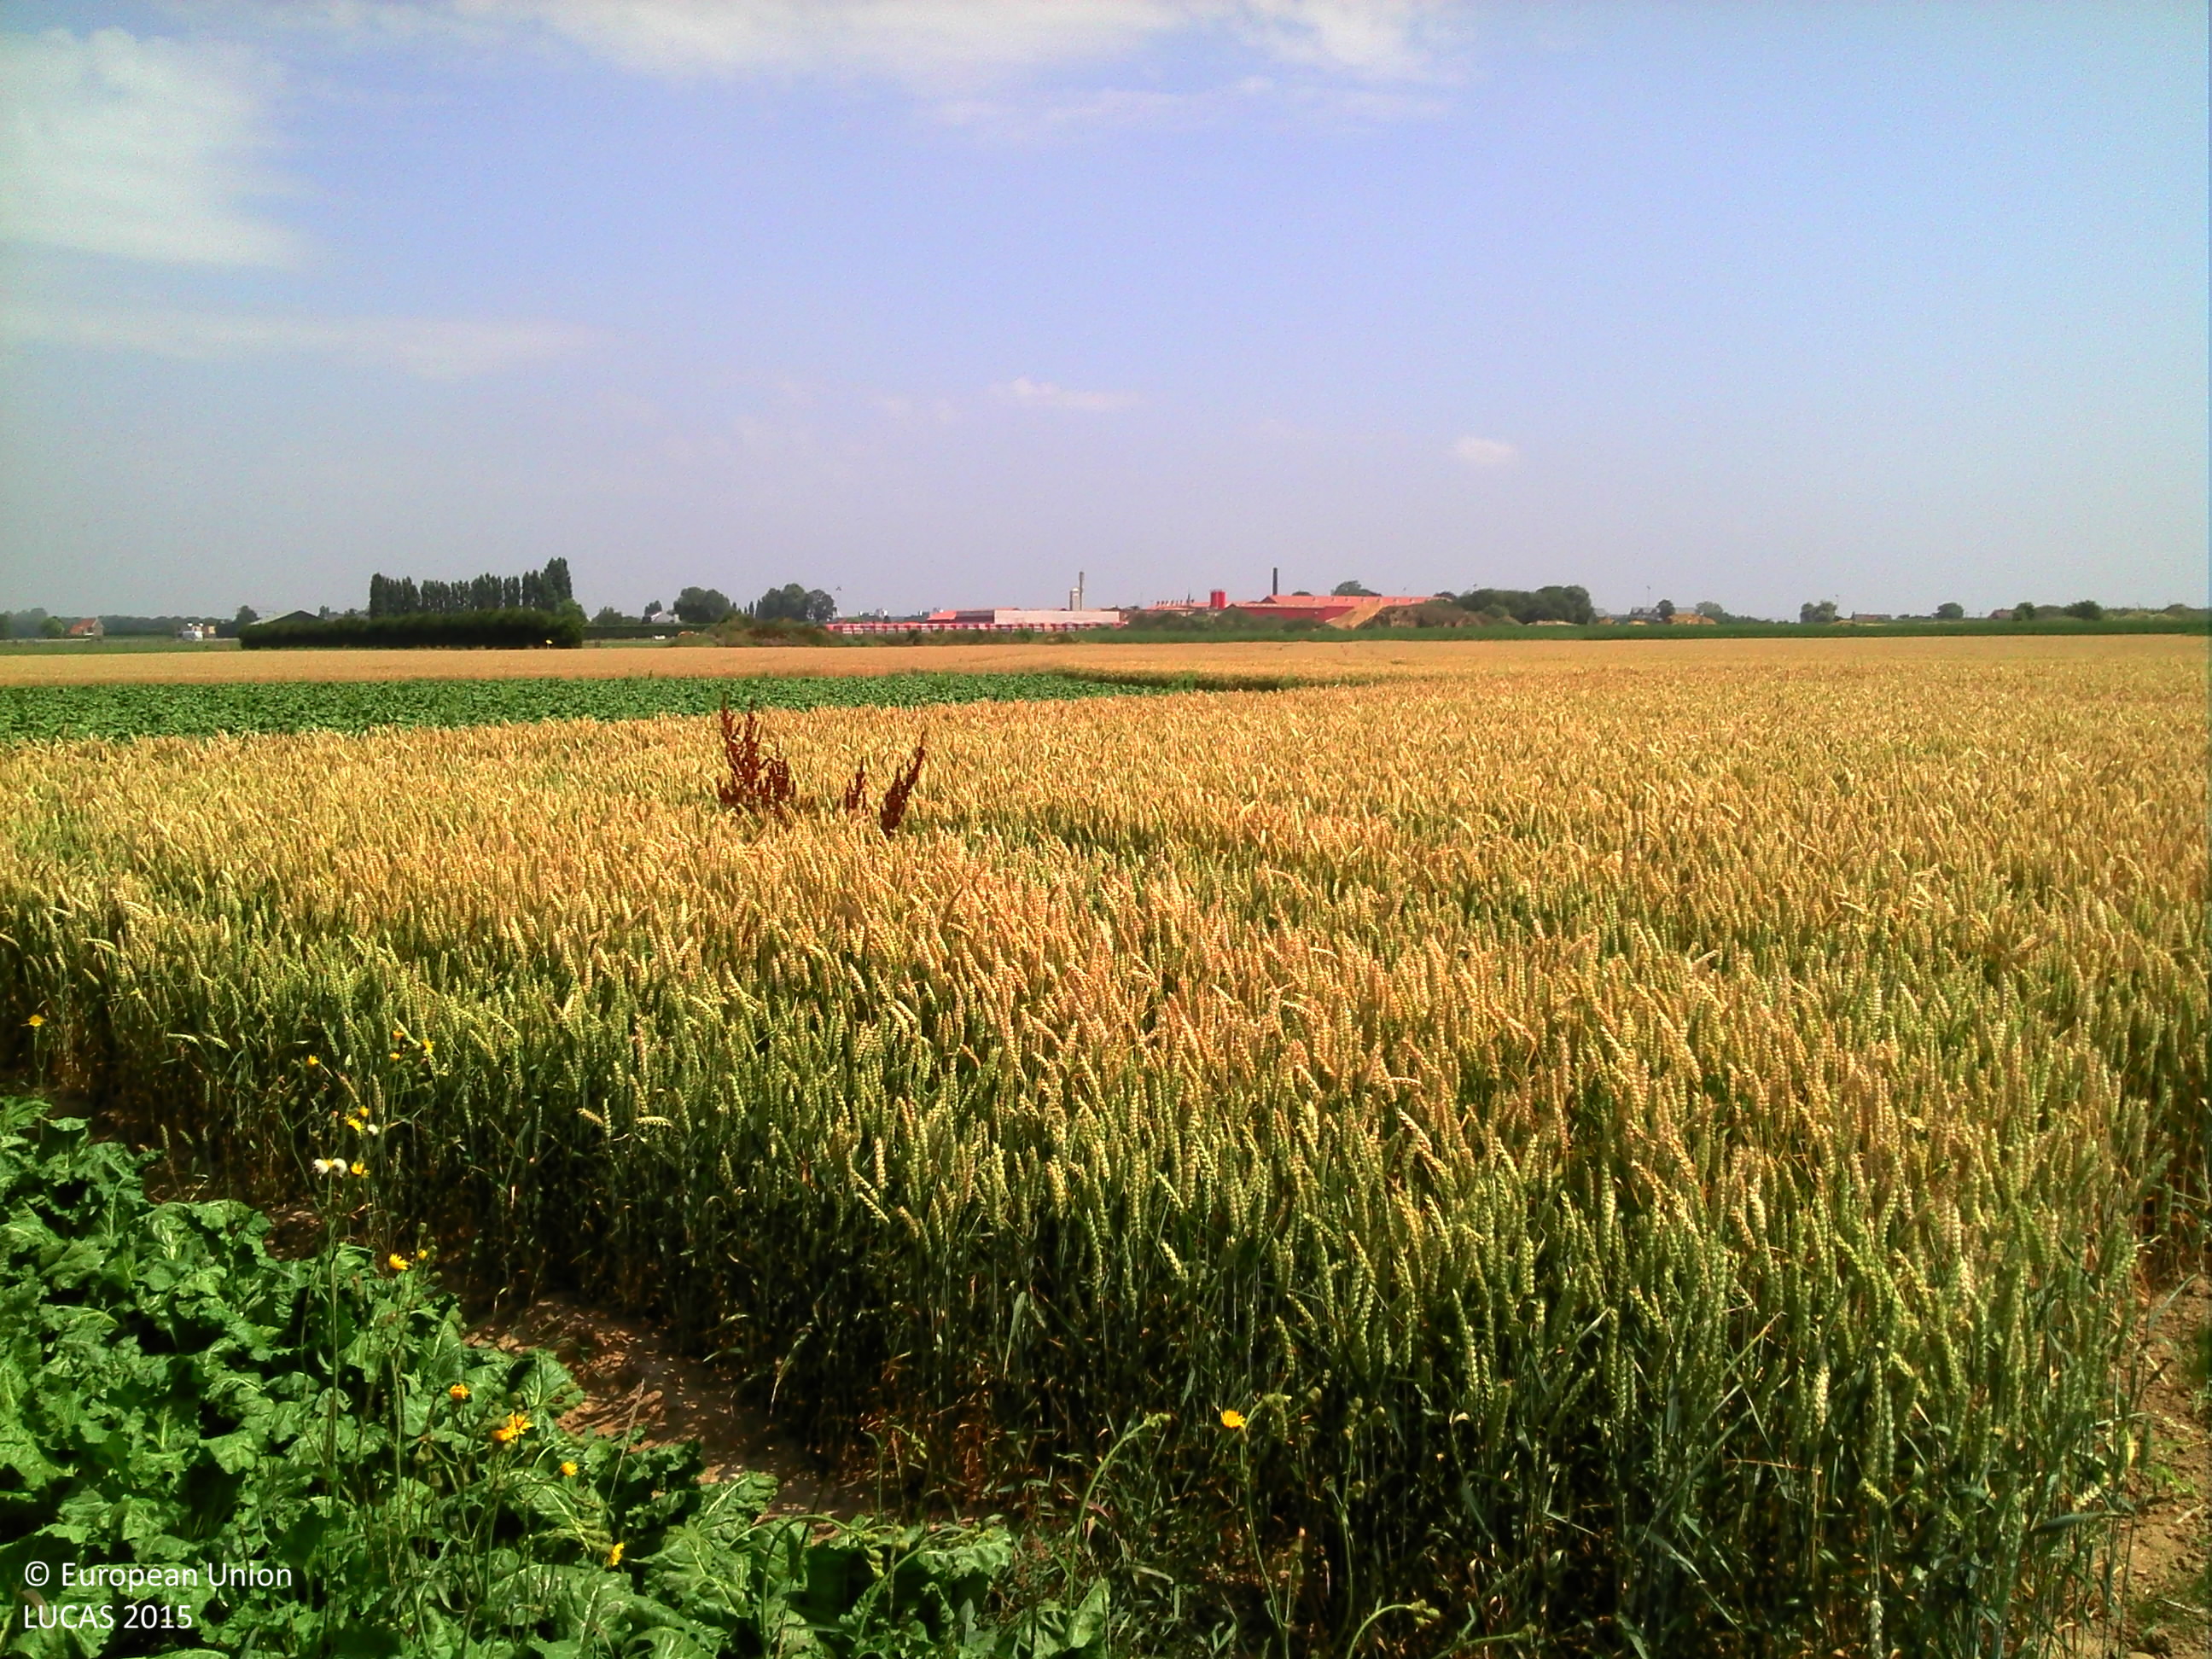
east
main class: Cropland
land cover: Sugar beet
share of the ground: > 75 %
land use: Agriculture (excluding fallow land and kitchen gardens)
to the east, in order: Sugar beet; Grass margins; Paved roads, cycling and walking lanes; Grass margins; Common wheat
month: July
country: BE
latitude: 50.8381
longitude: 5.6105
